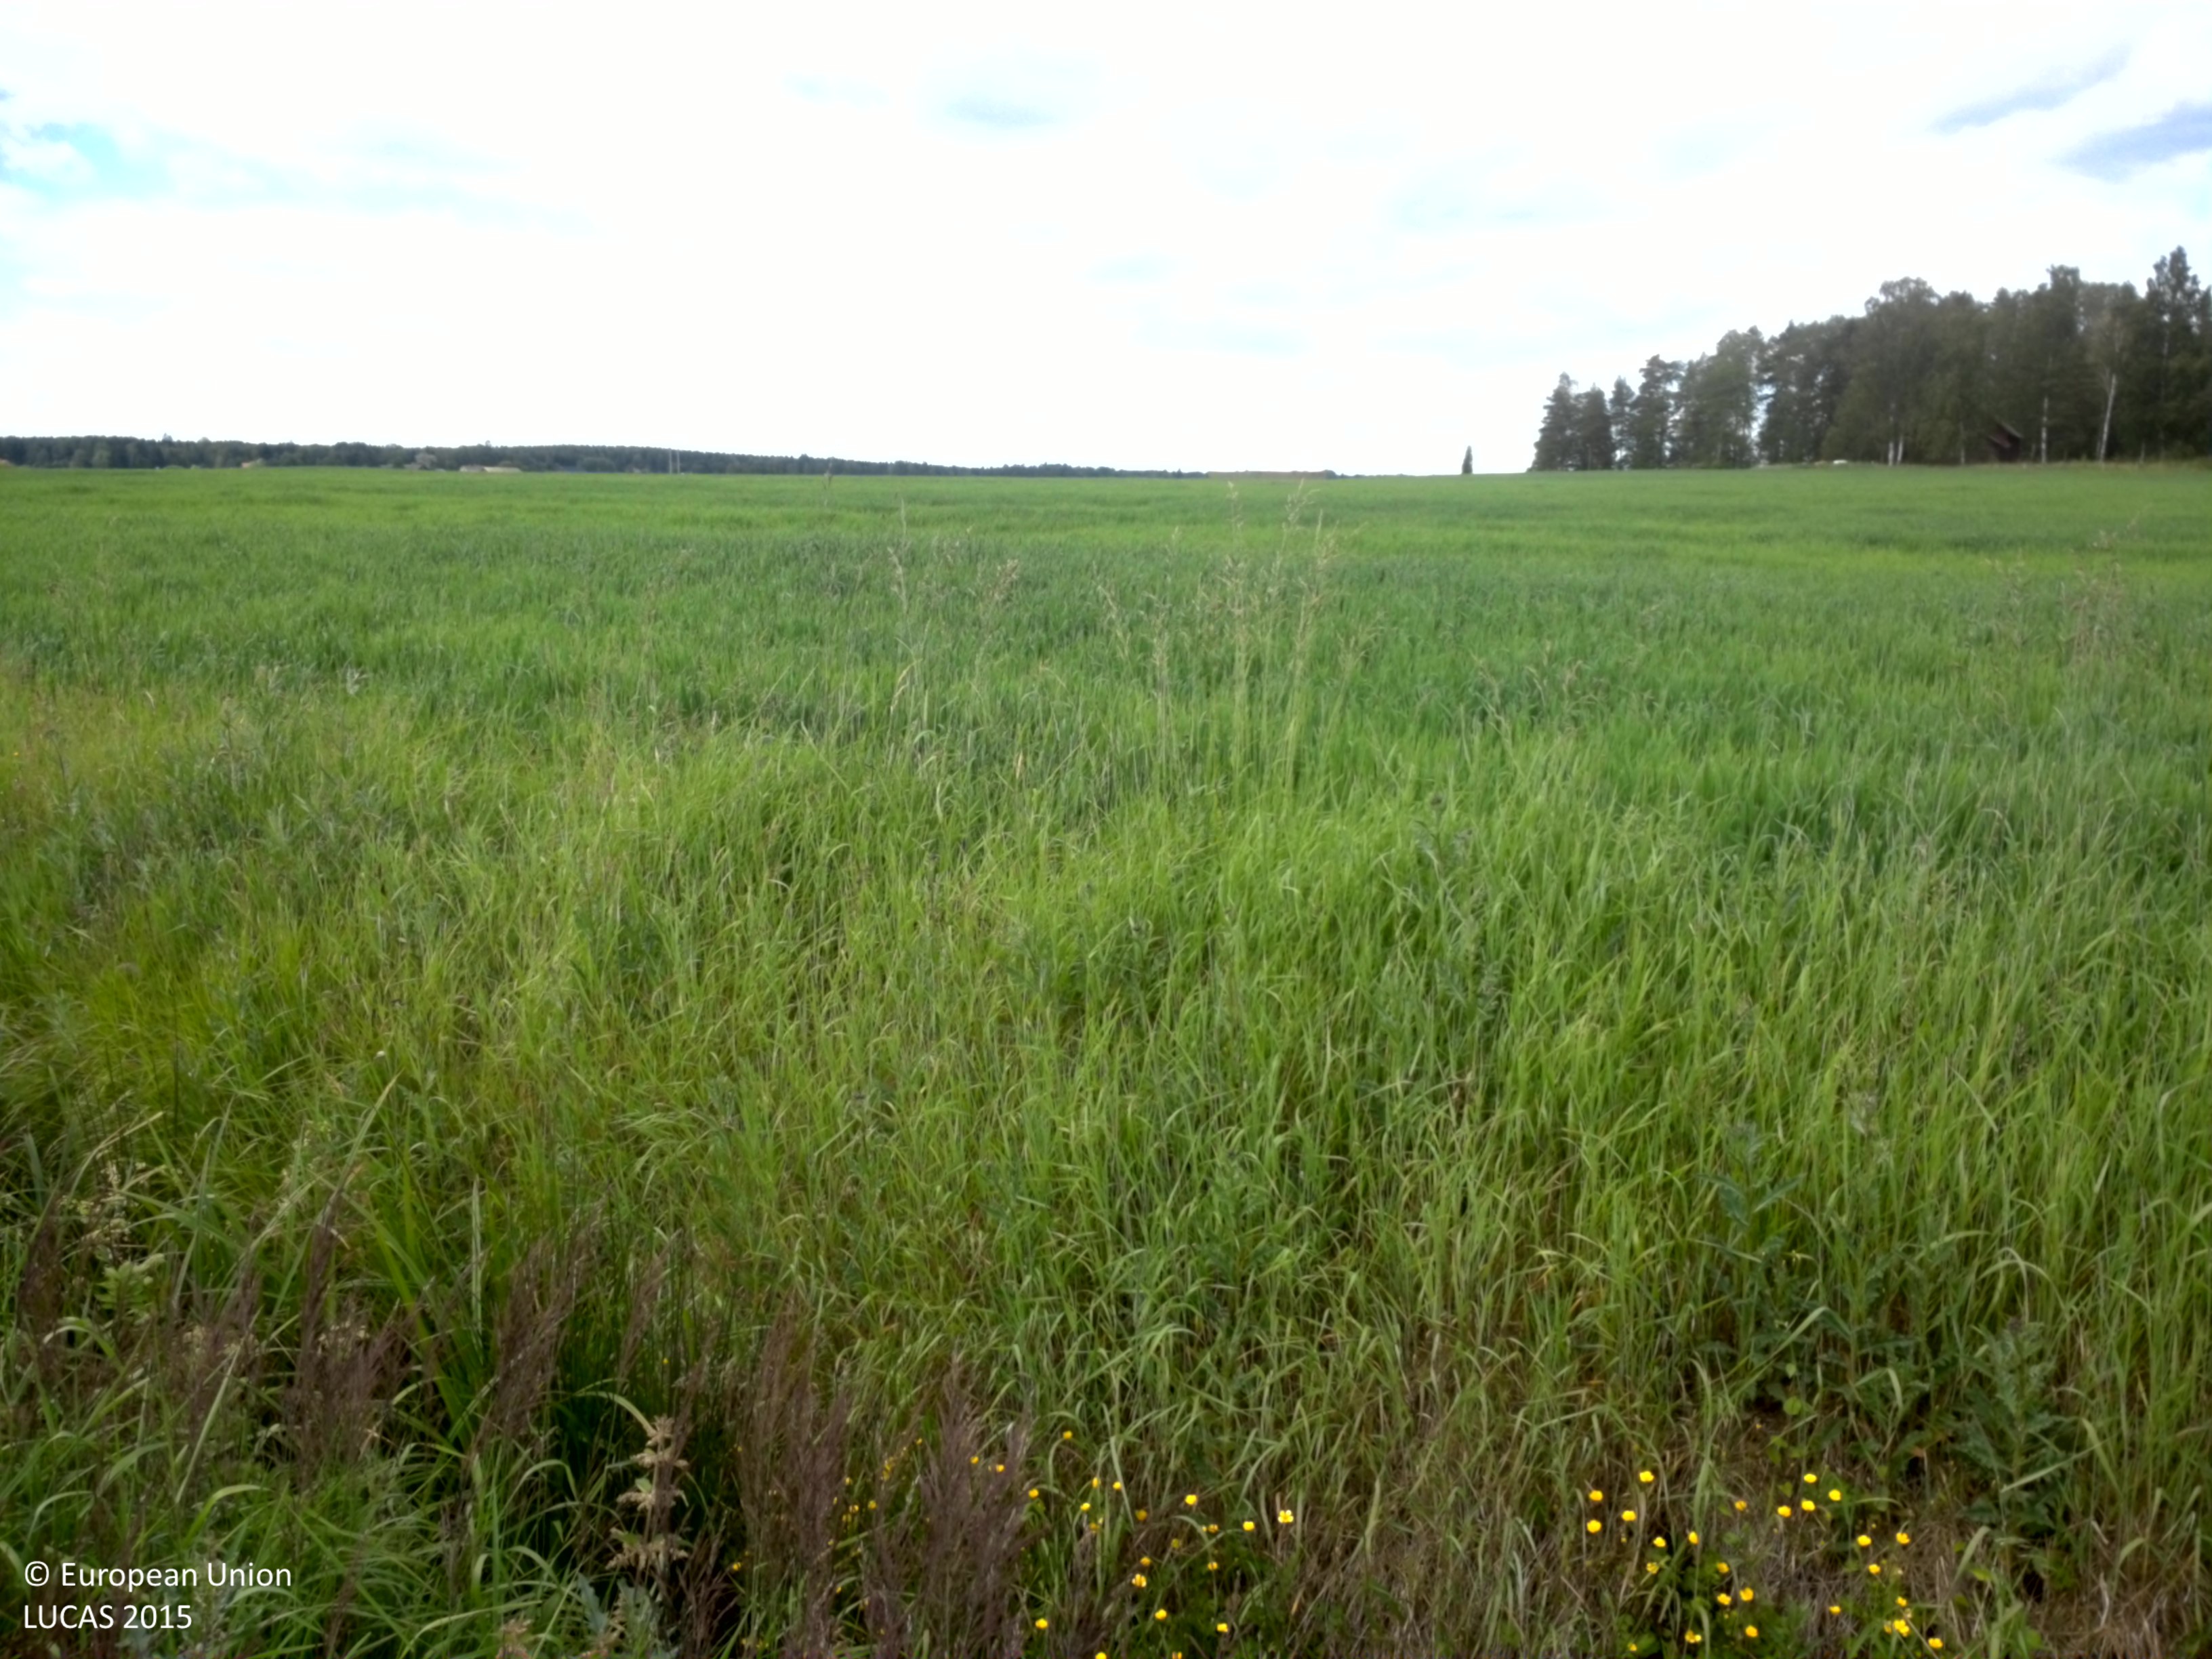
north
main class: Cropland
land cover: Oats
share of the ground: > 75 %
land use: Agriculture (excluding fallow land and kitchen gardens)
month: July
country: SE
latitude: 60.0263
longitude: 16.9719
